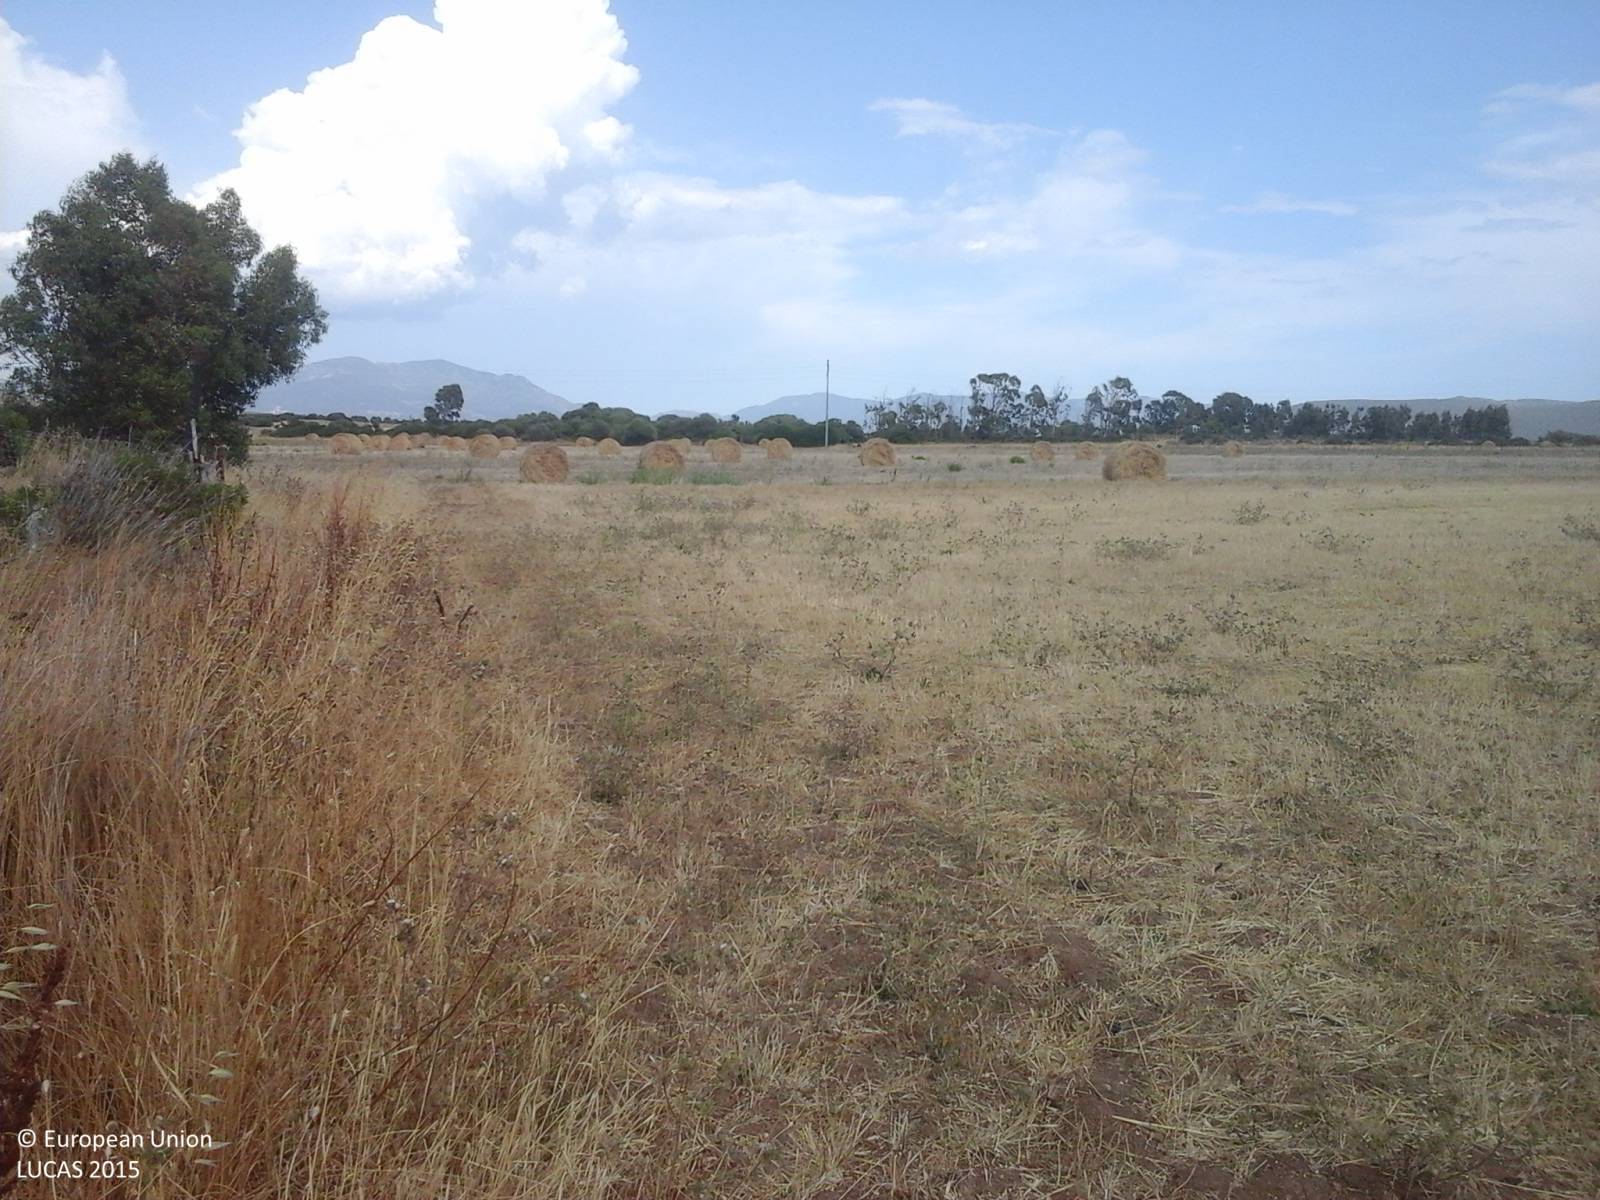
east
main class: Grassland
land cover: Grassland without tree/shrub cover
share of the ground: > 75 %
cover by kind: herbaceous plants 85 %, unconsolidated bare surface 15 %
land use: Agriculture (excluding fallow land and kitchen gardens)
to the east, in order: Grassland without tree/shrub cover; Fences; Oats; Electric lines; Oats
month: July
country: IT
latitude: 39.0796
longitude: 8.5871
